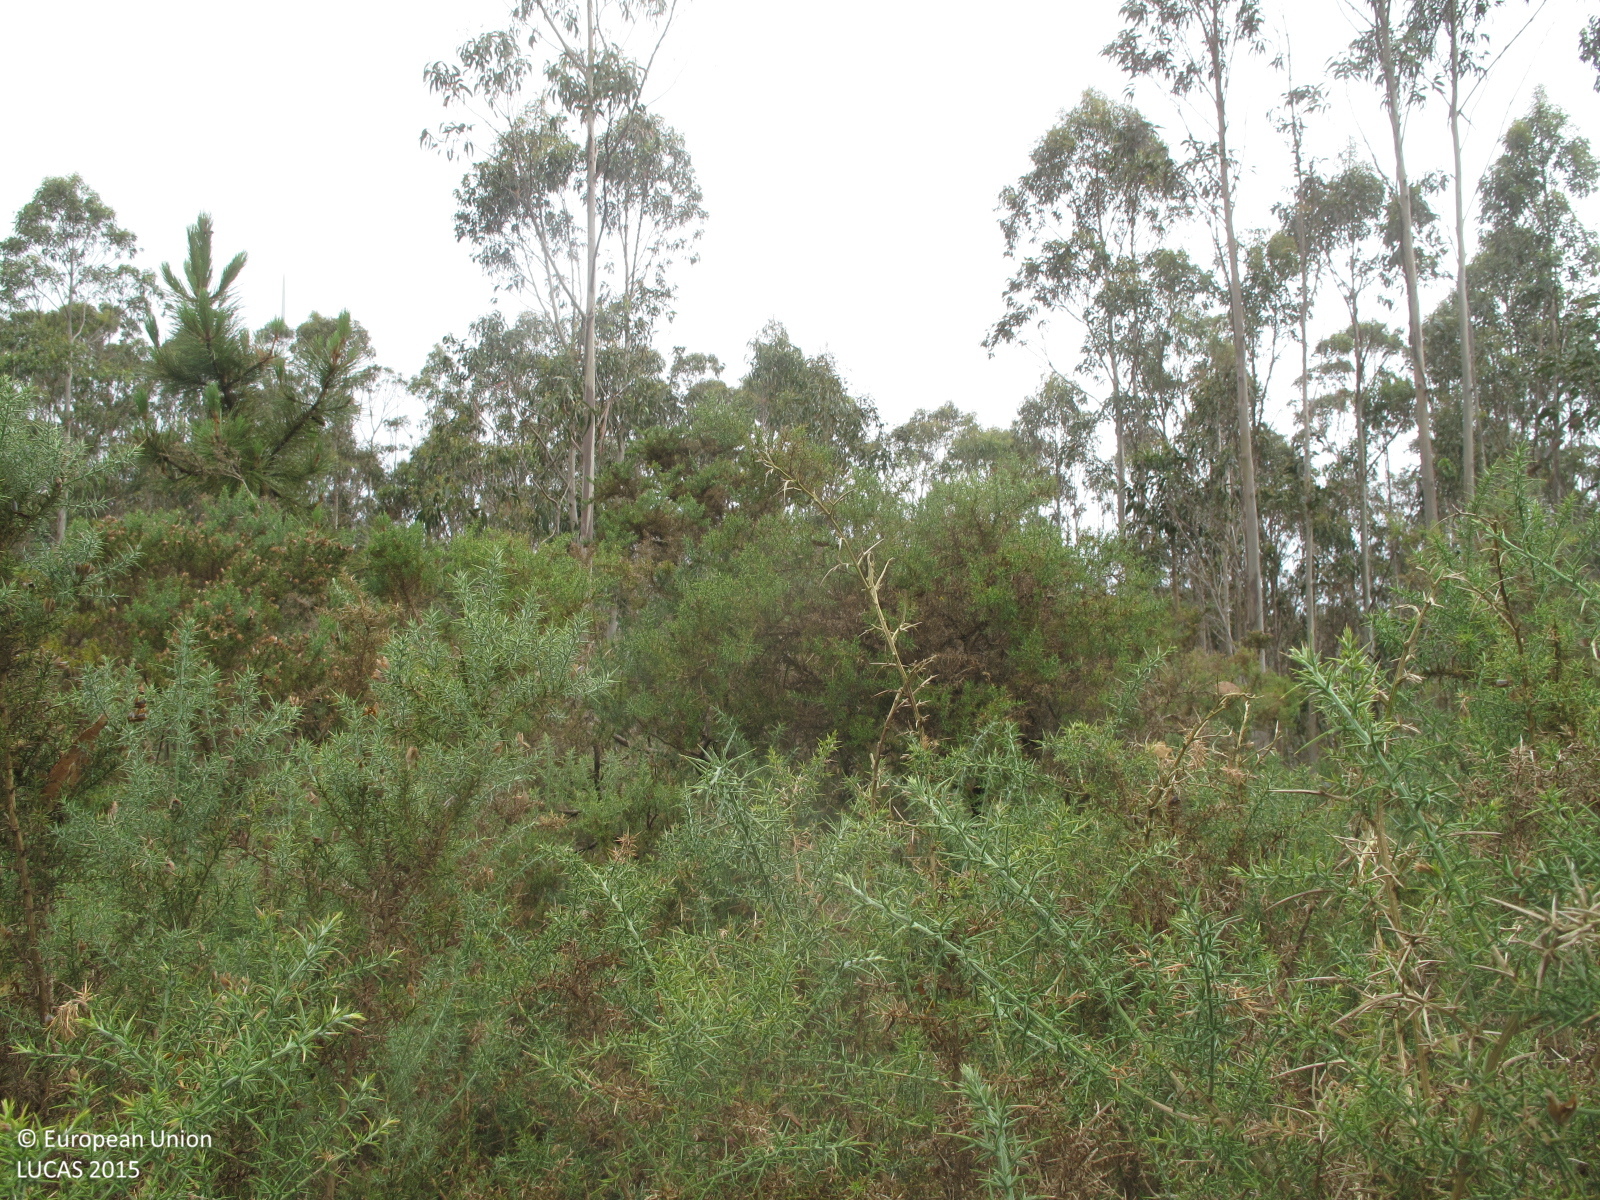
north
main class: Woodland
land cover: Broadleaved woodland
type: exotic forest
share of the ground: 25 - 50 %
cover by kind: shrubs 60 %, broadleaved forest trees 30 %, herbaceous plants 10 %
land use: Forestry
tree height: > 5 m
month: July
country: ES
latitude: 43.5873
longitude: -8.1215
